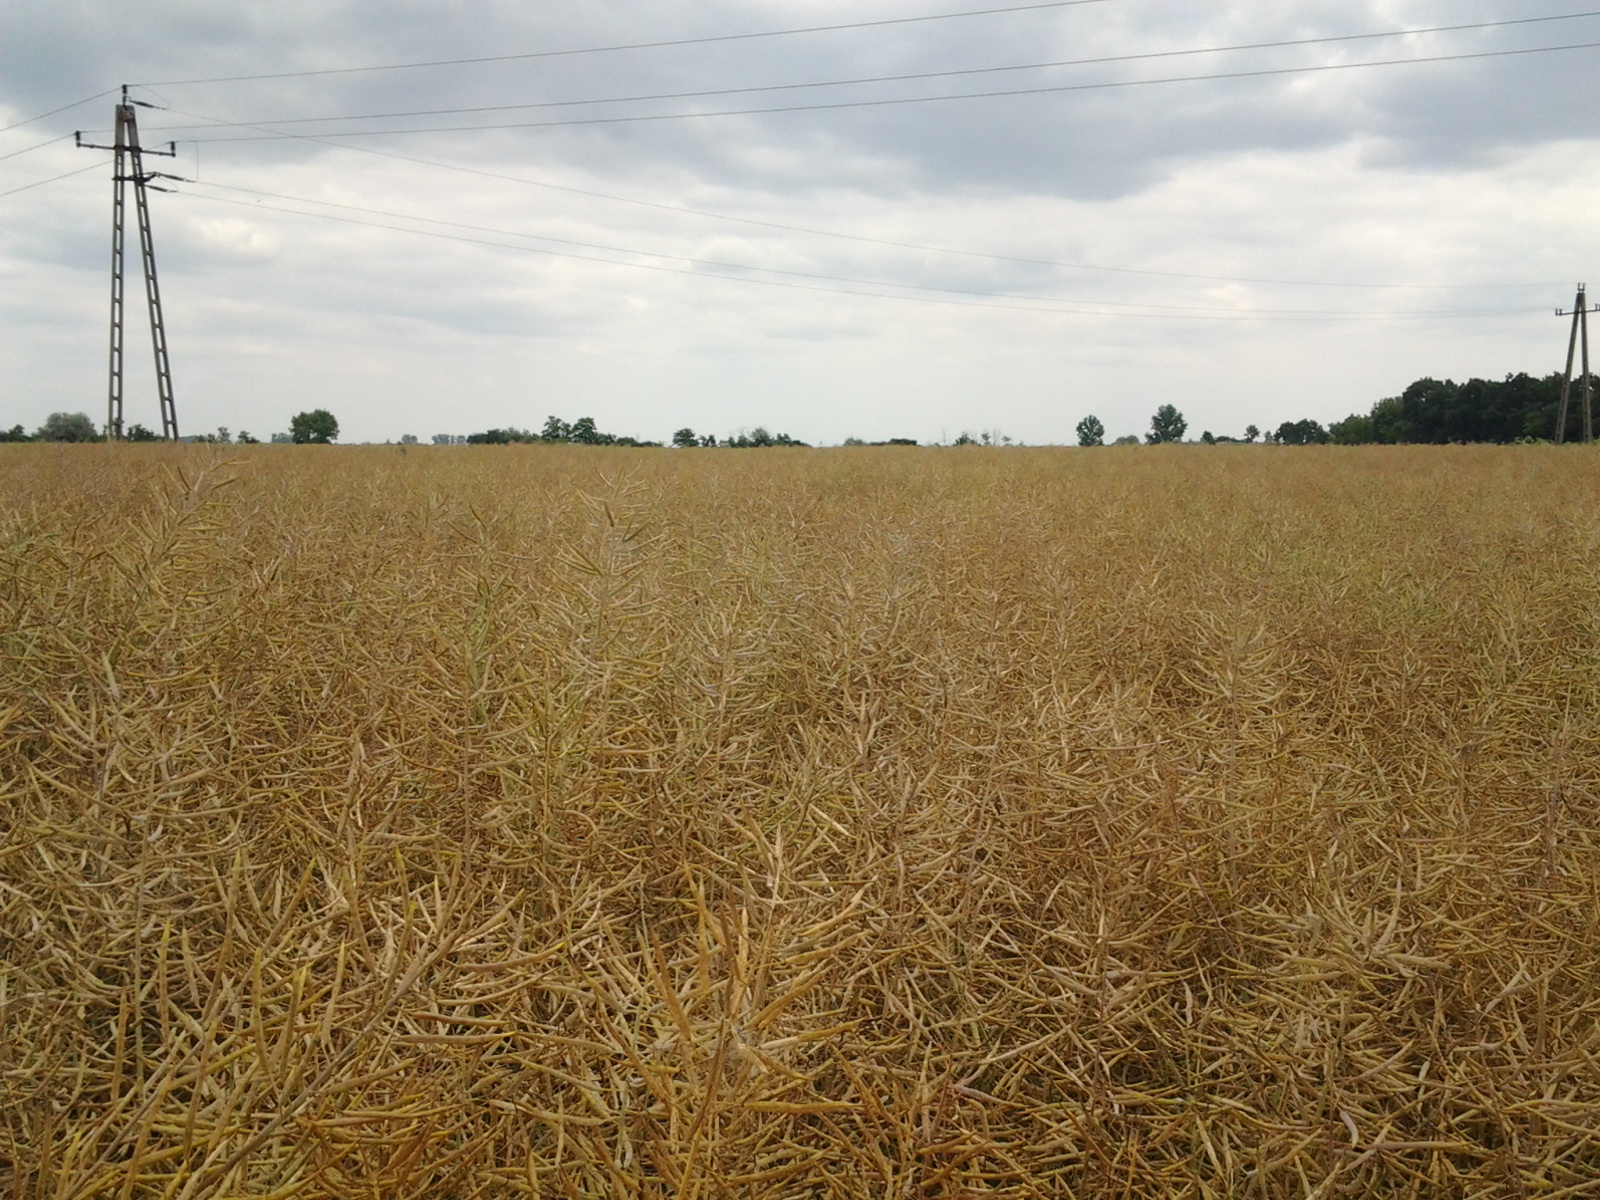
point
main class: Cropland
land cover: Rape and turnip rape
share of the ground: > 75 %
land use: Agriculture (excluding fallow land and kitchen gardens)
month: June
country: HU
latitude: 47.6258
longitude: 19.9664
